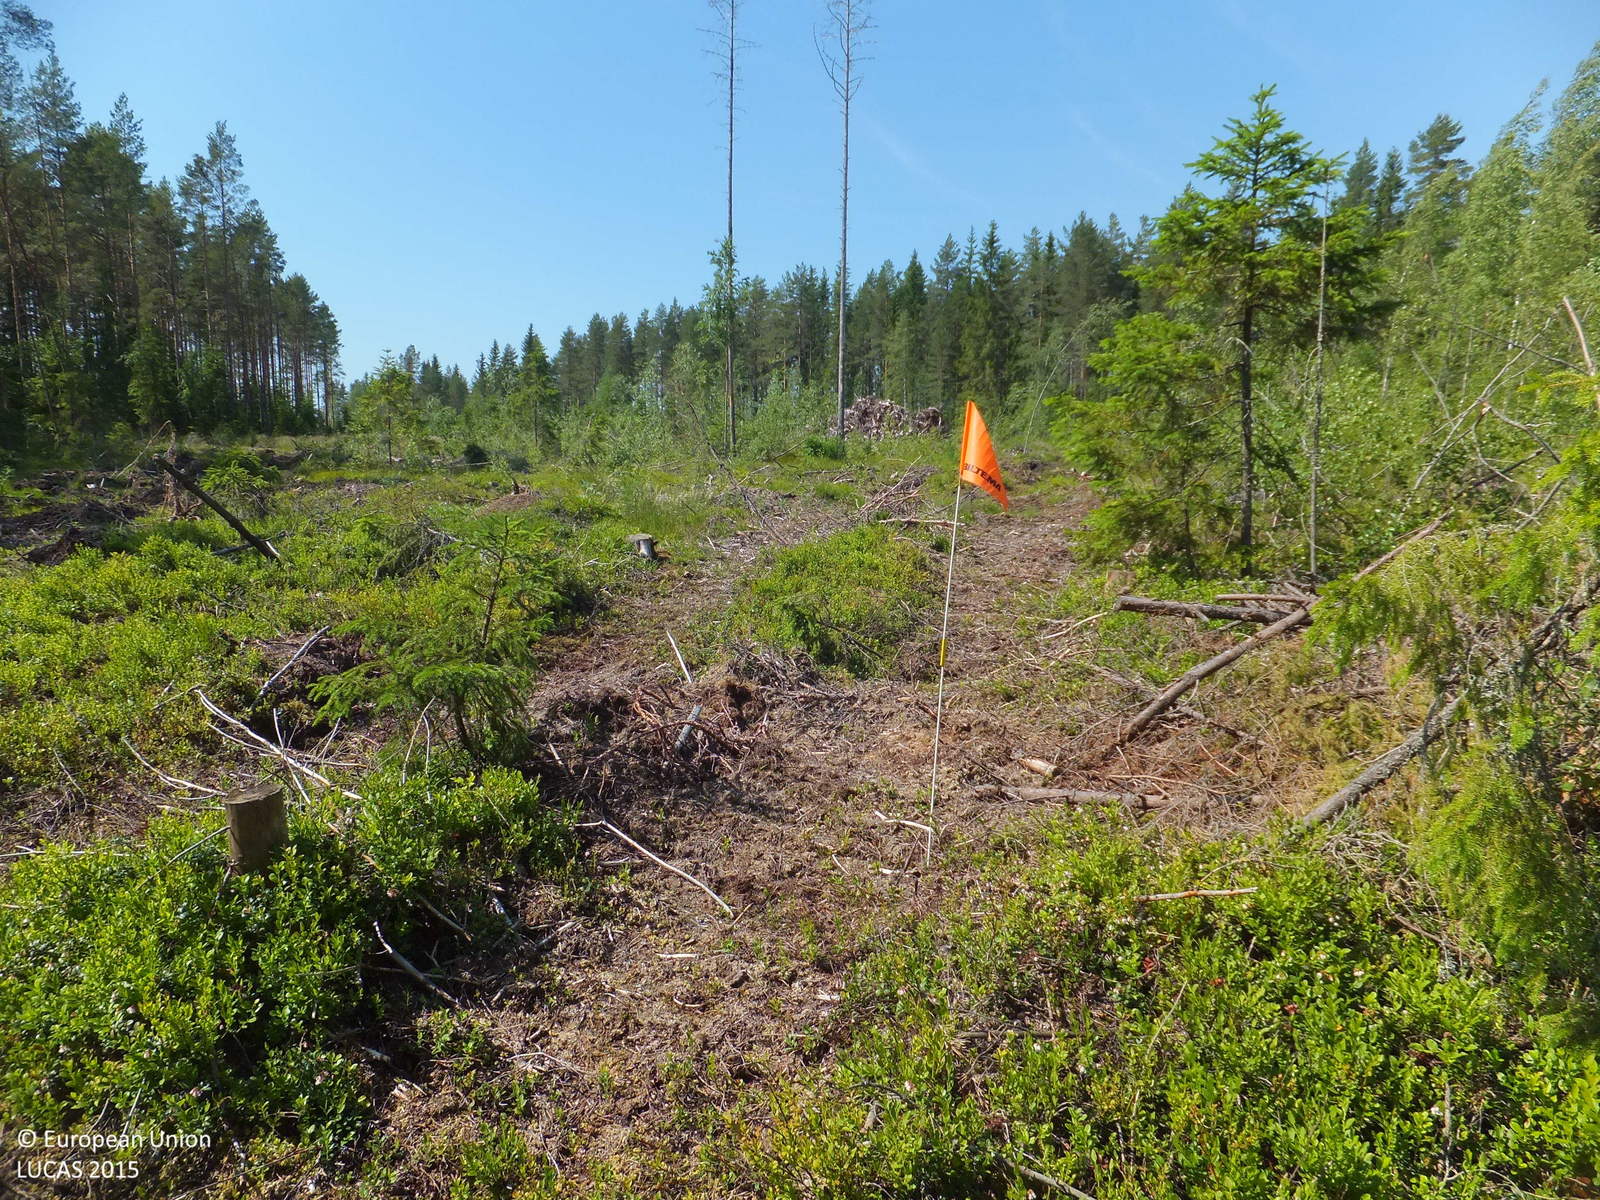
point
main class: Shrubland
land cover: Shrubland with sparse tree cover
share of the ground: 50 - 75 %
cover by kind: shrubs 45 %, herbaceous plants 20 %, unconsolidated bare surface 15 %, coniferous forest trees 5 %, lichens and mosses 5 %
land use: Forestry
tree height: < 5 m
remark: Clear cut
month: July
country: FI
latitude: 63.2026
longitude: 23.8081
